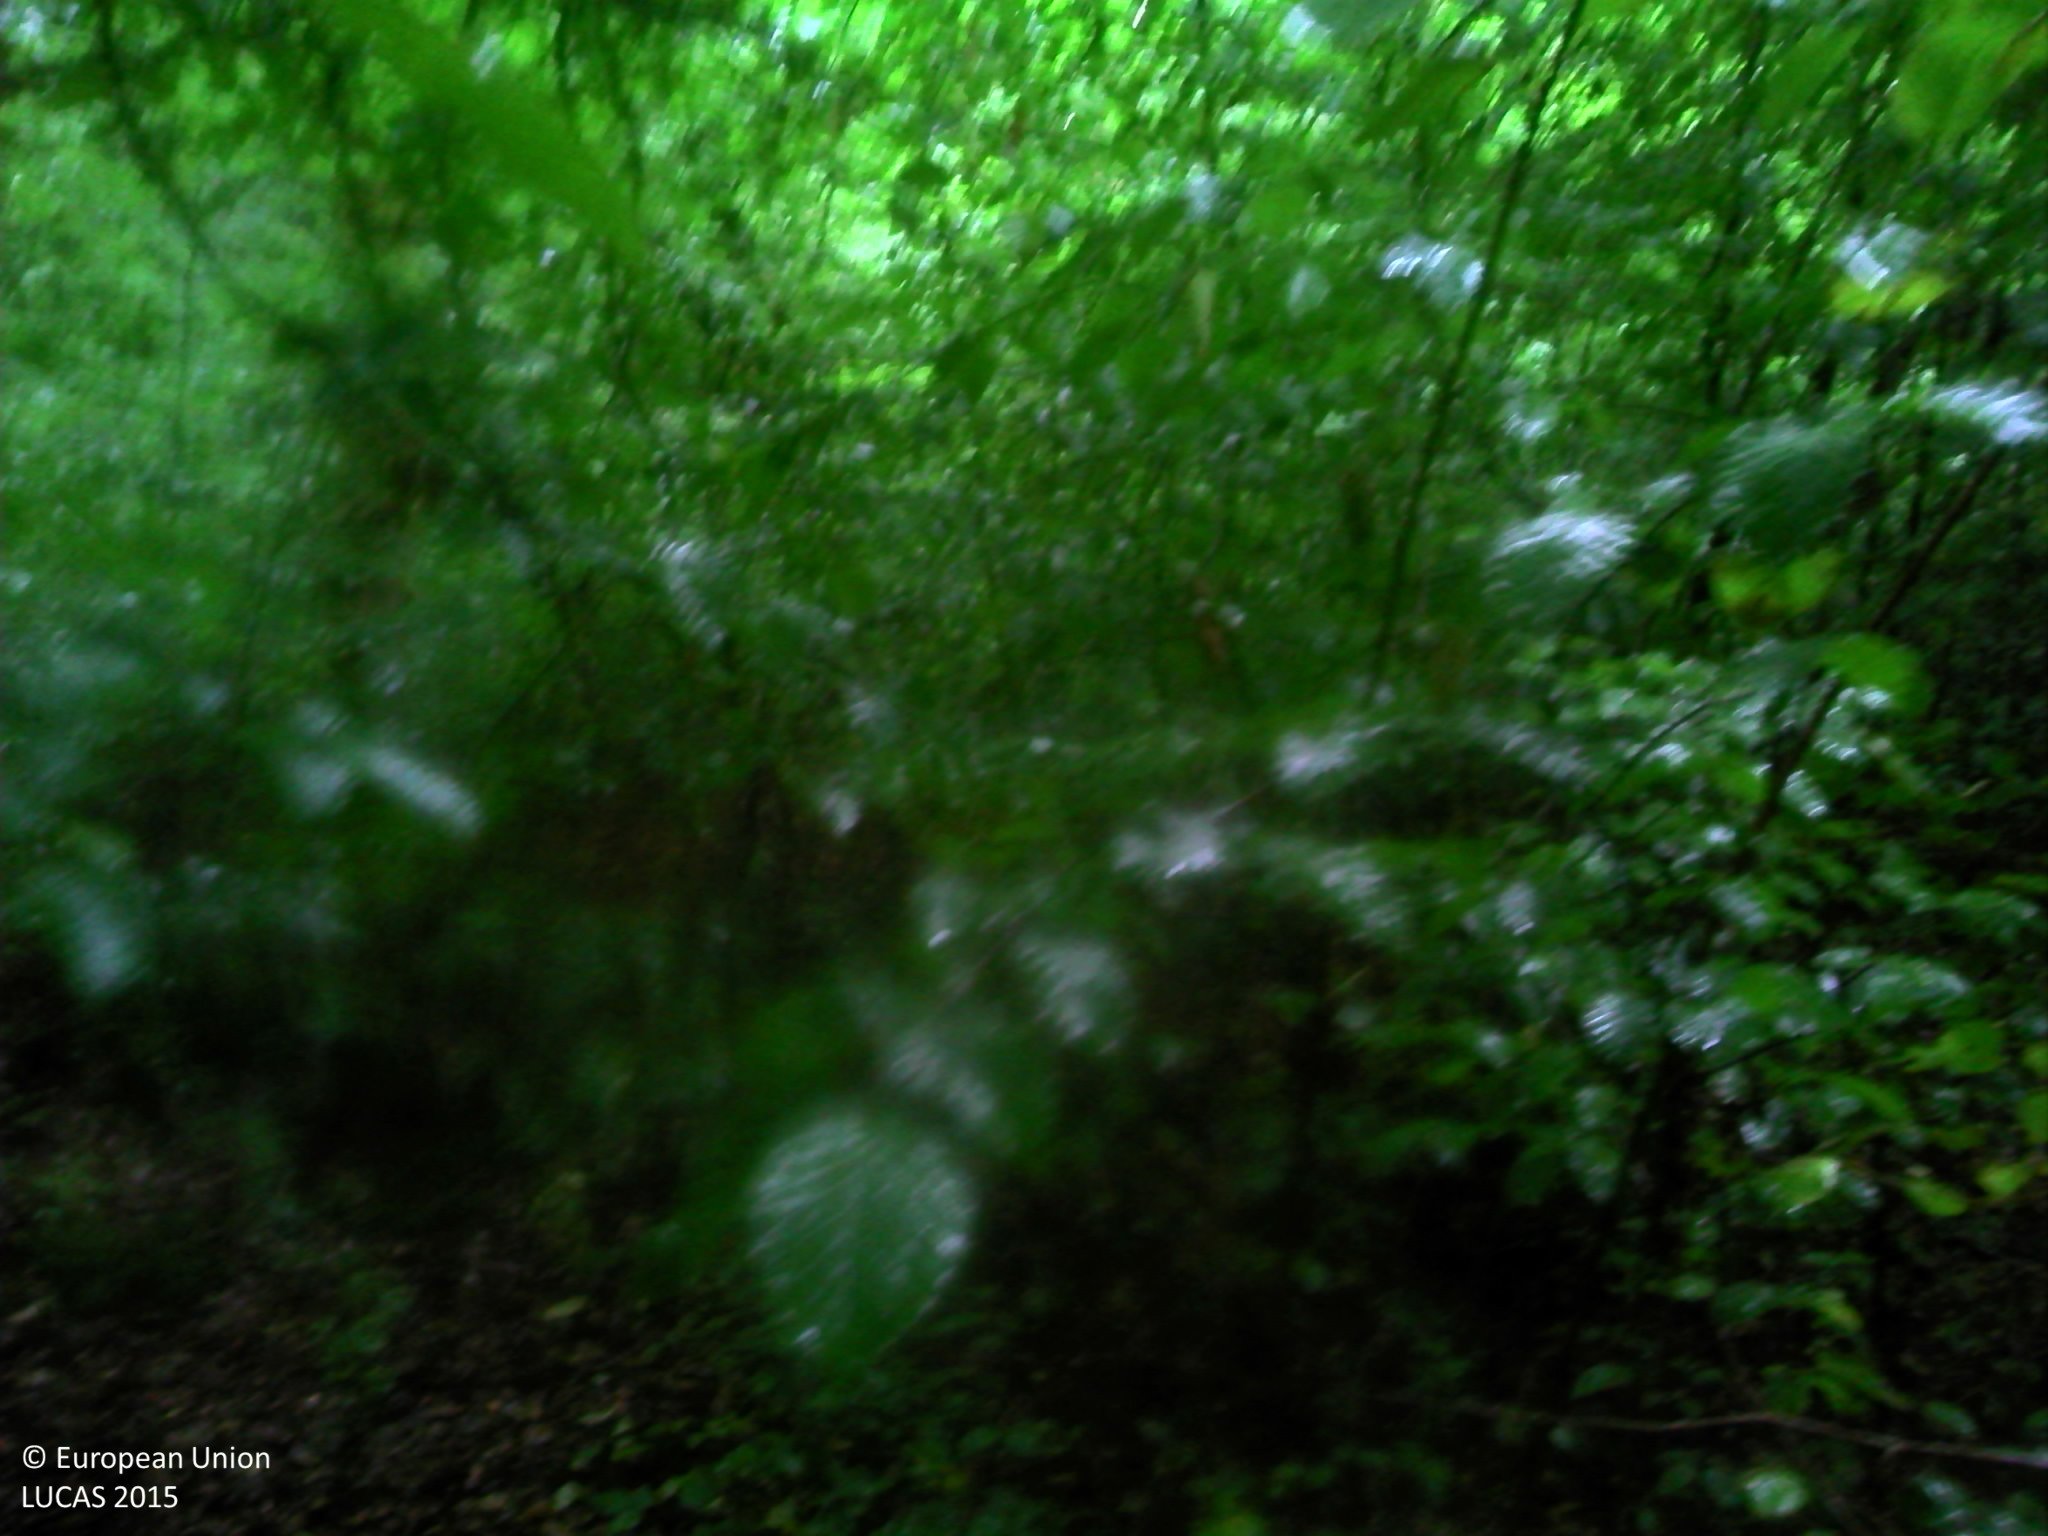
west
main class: Woodland
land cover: Broadleaved woodland
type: mesophytic deciduous forest
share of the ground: > 75 %
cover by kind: broadleaved forest trees 100 %
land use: Forestry
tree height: > 5 m
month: July
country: BE
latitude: 50.1302
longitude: 4.6385
